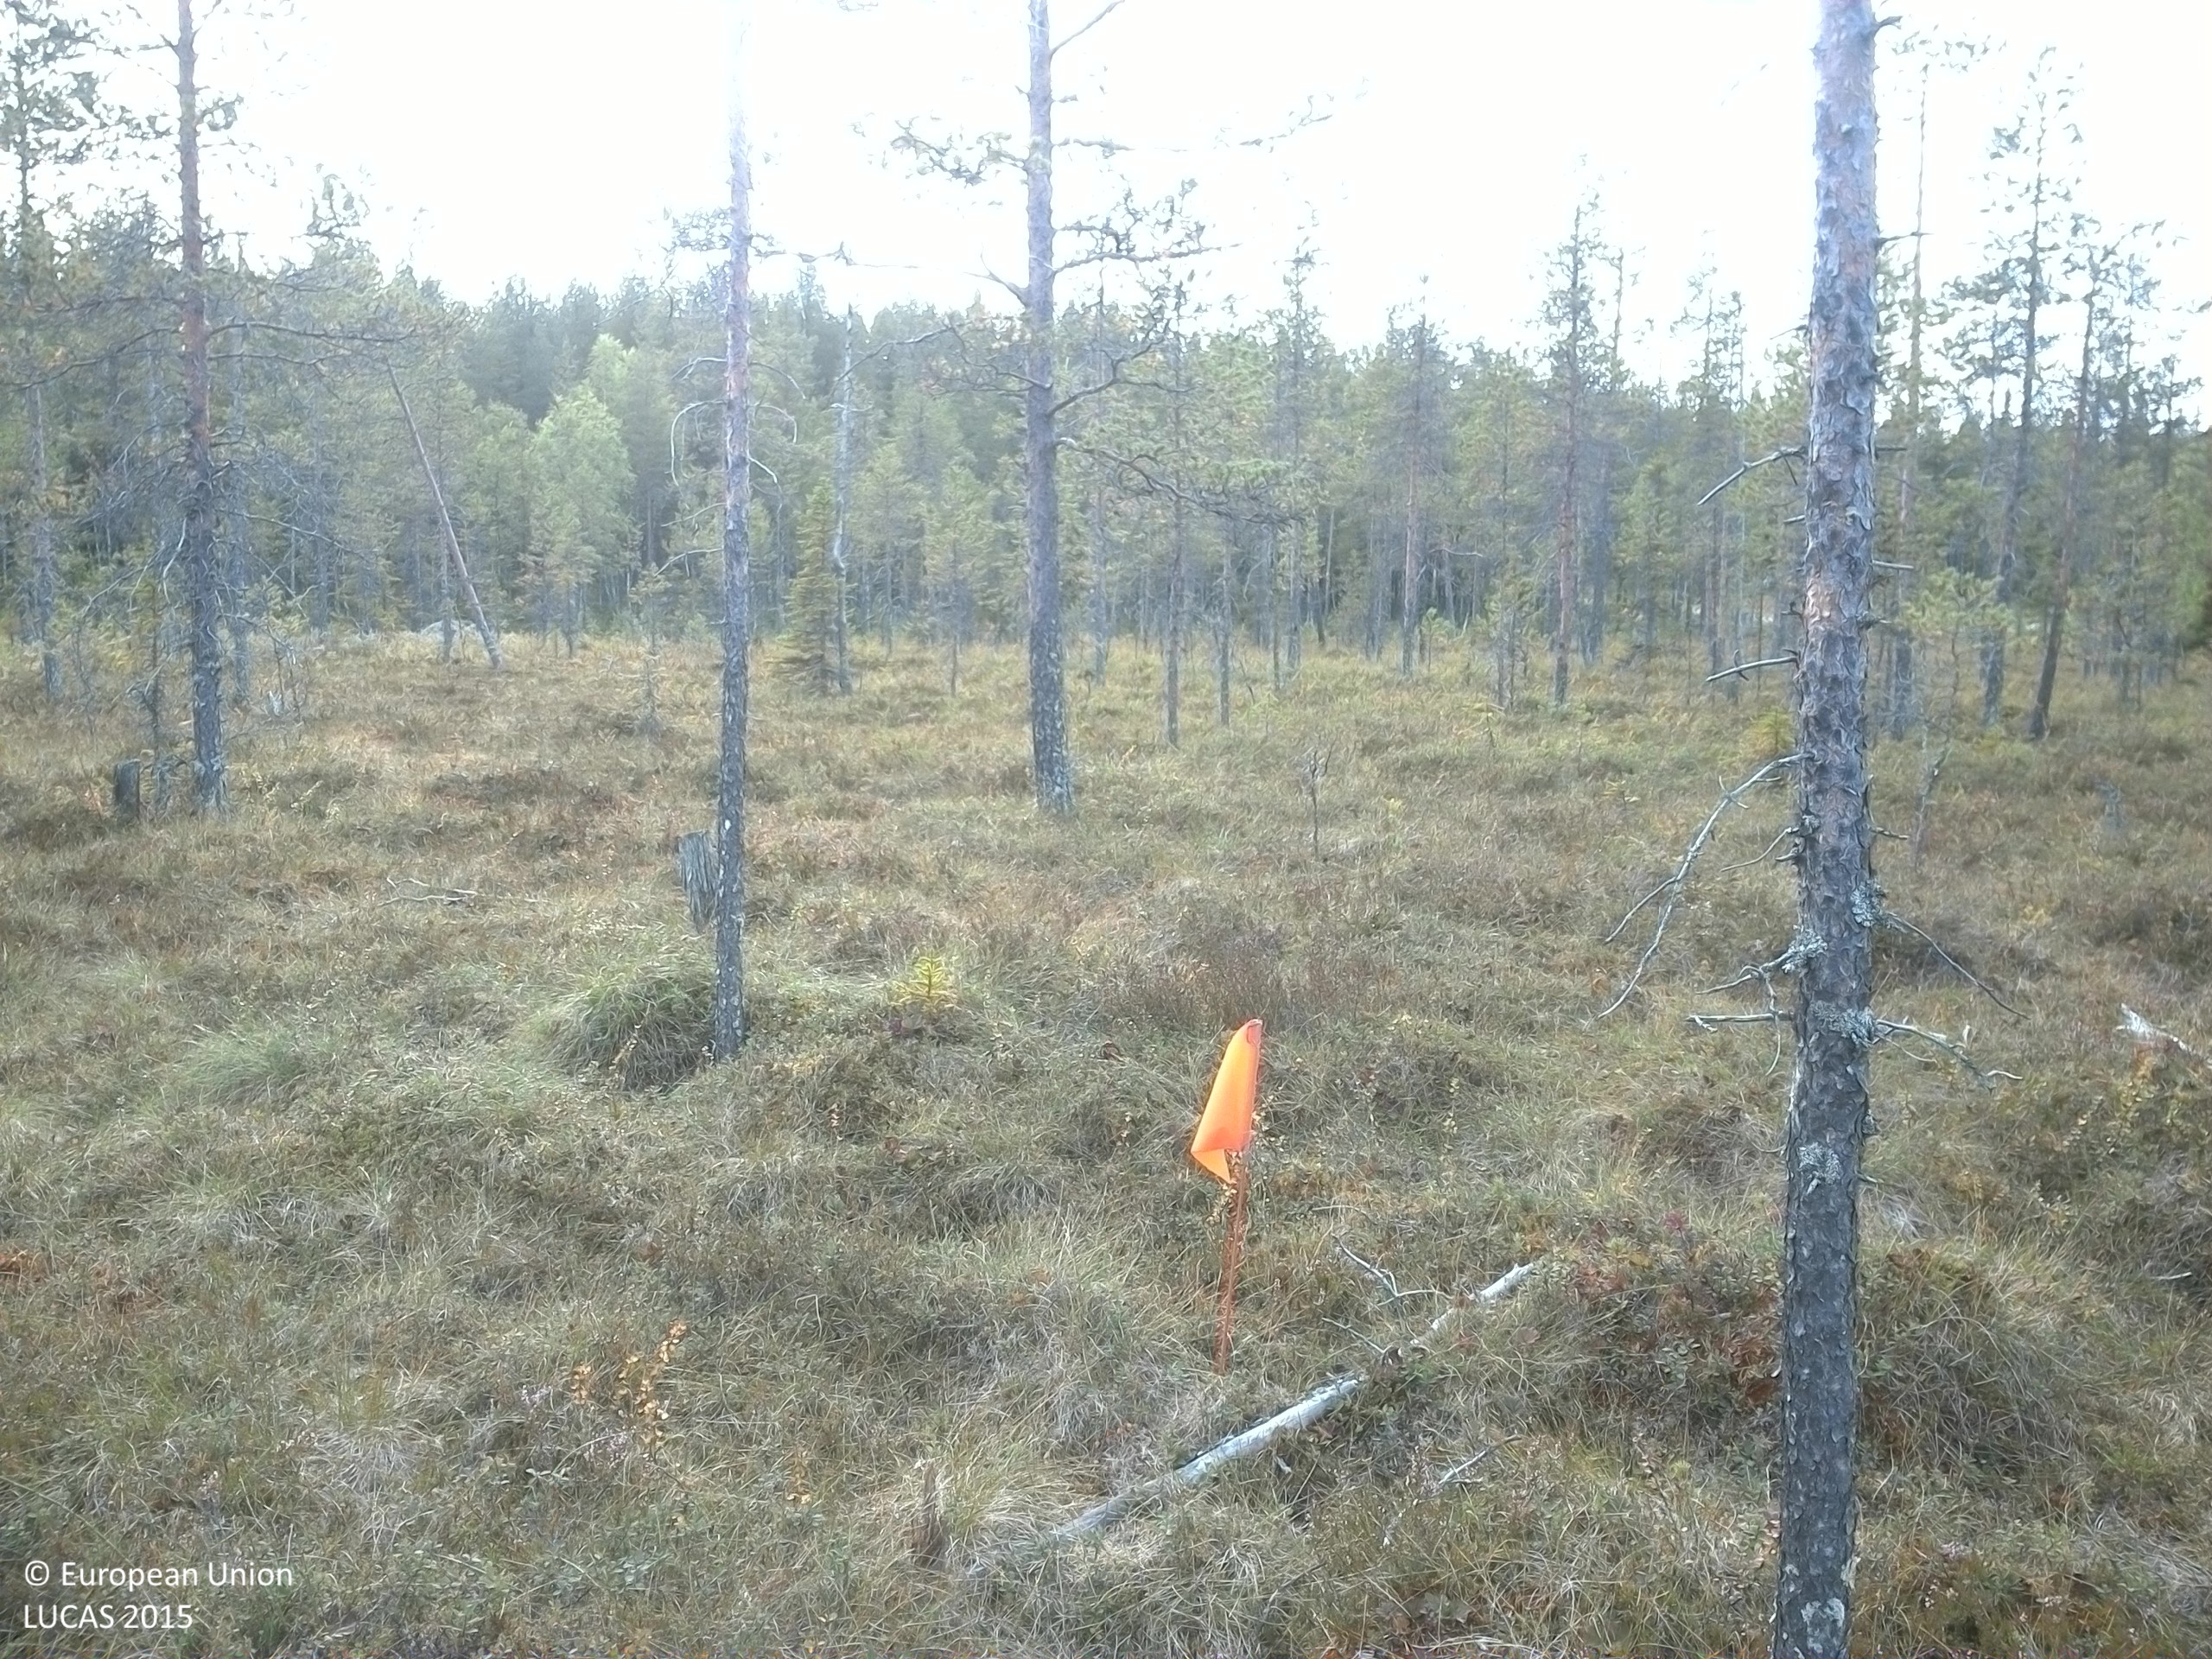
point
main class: Woodland
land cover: Pine dominated coniferous woodland
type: boreal forest
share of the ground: 10 - 25 %
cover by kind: lichens and mosses 40 %, shrubs 30 %, coniferous forest trees 20 %, herbaceous plants 10 %
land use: Semi-natural and natural areas not in use
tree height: > 5 m
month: September
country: SE
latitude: 64.0302
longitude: 17.6870
